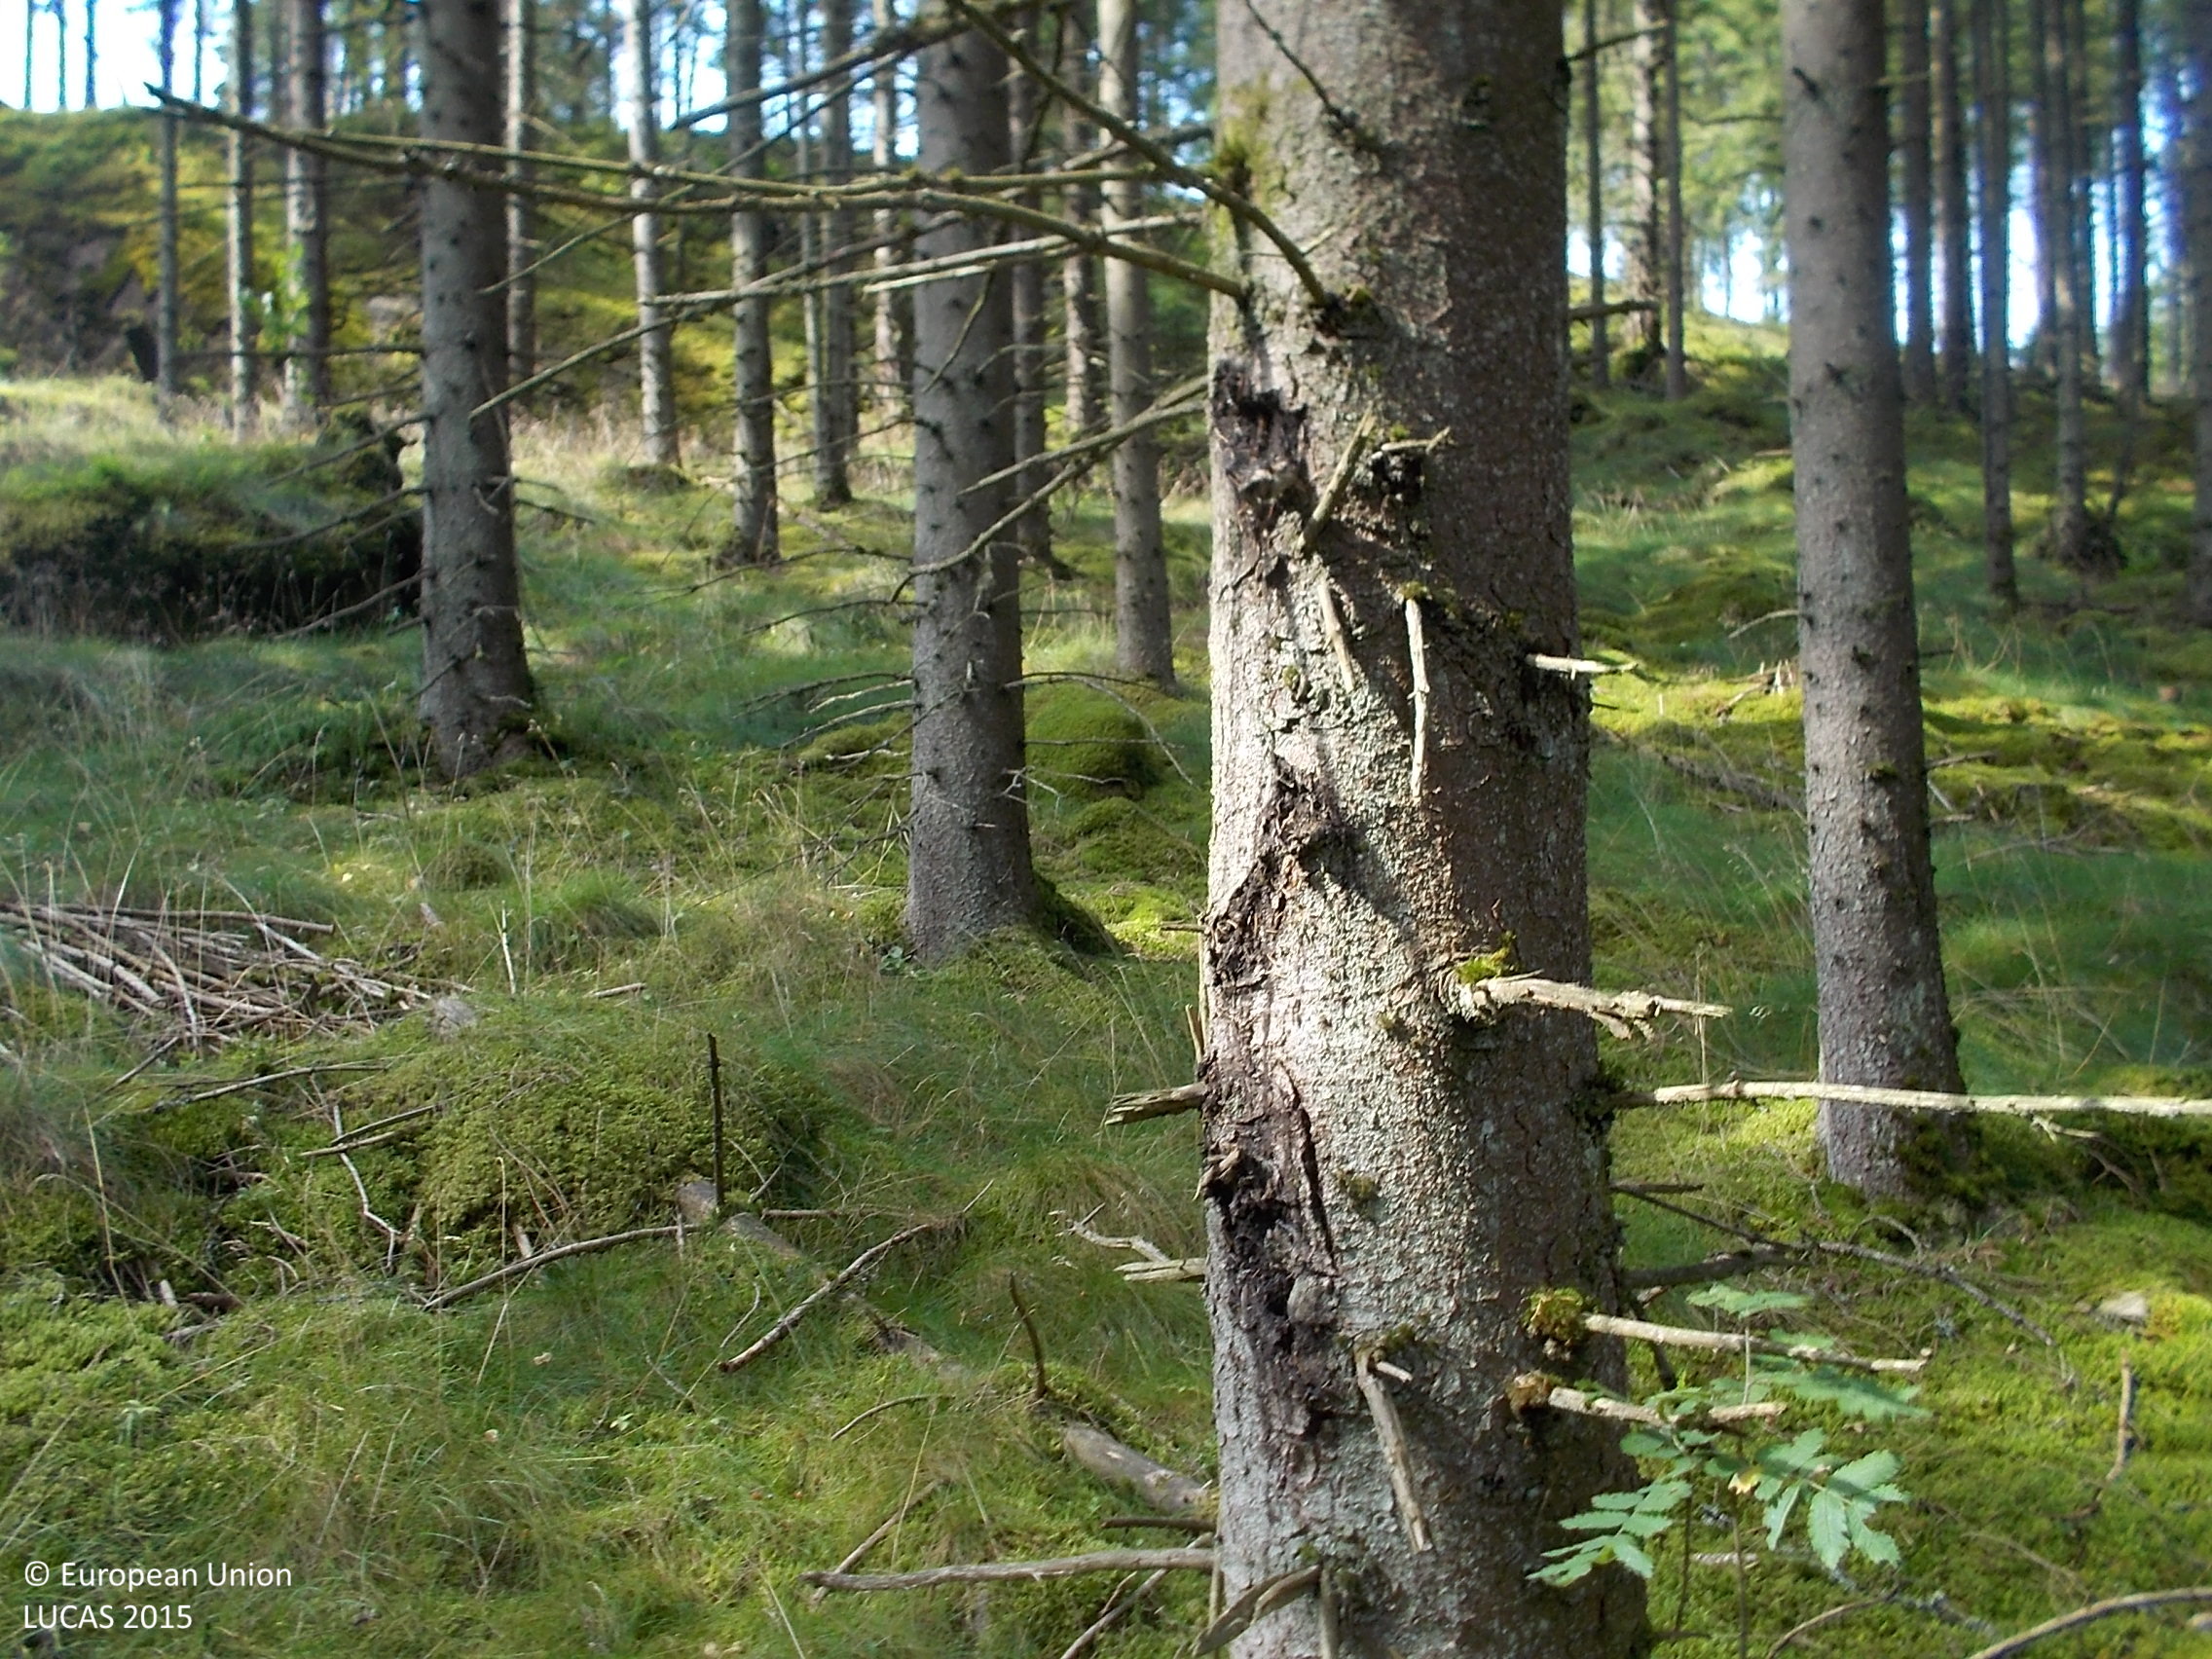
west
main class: Woodland
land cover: Spruce dominated coniferous woodland
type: boreal forest
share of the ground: > 75 %
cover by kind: coniferous forest trees 85 %, herbaceous plants 10 %, lichens and mosses 5 %
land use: Forestry
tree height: > 5 m
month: August
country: SE
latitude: 57.3222
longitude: 13.0018
